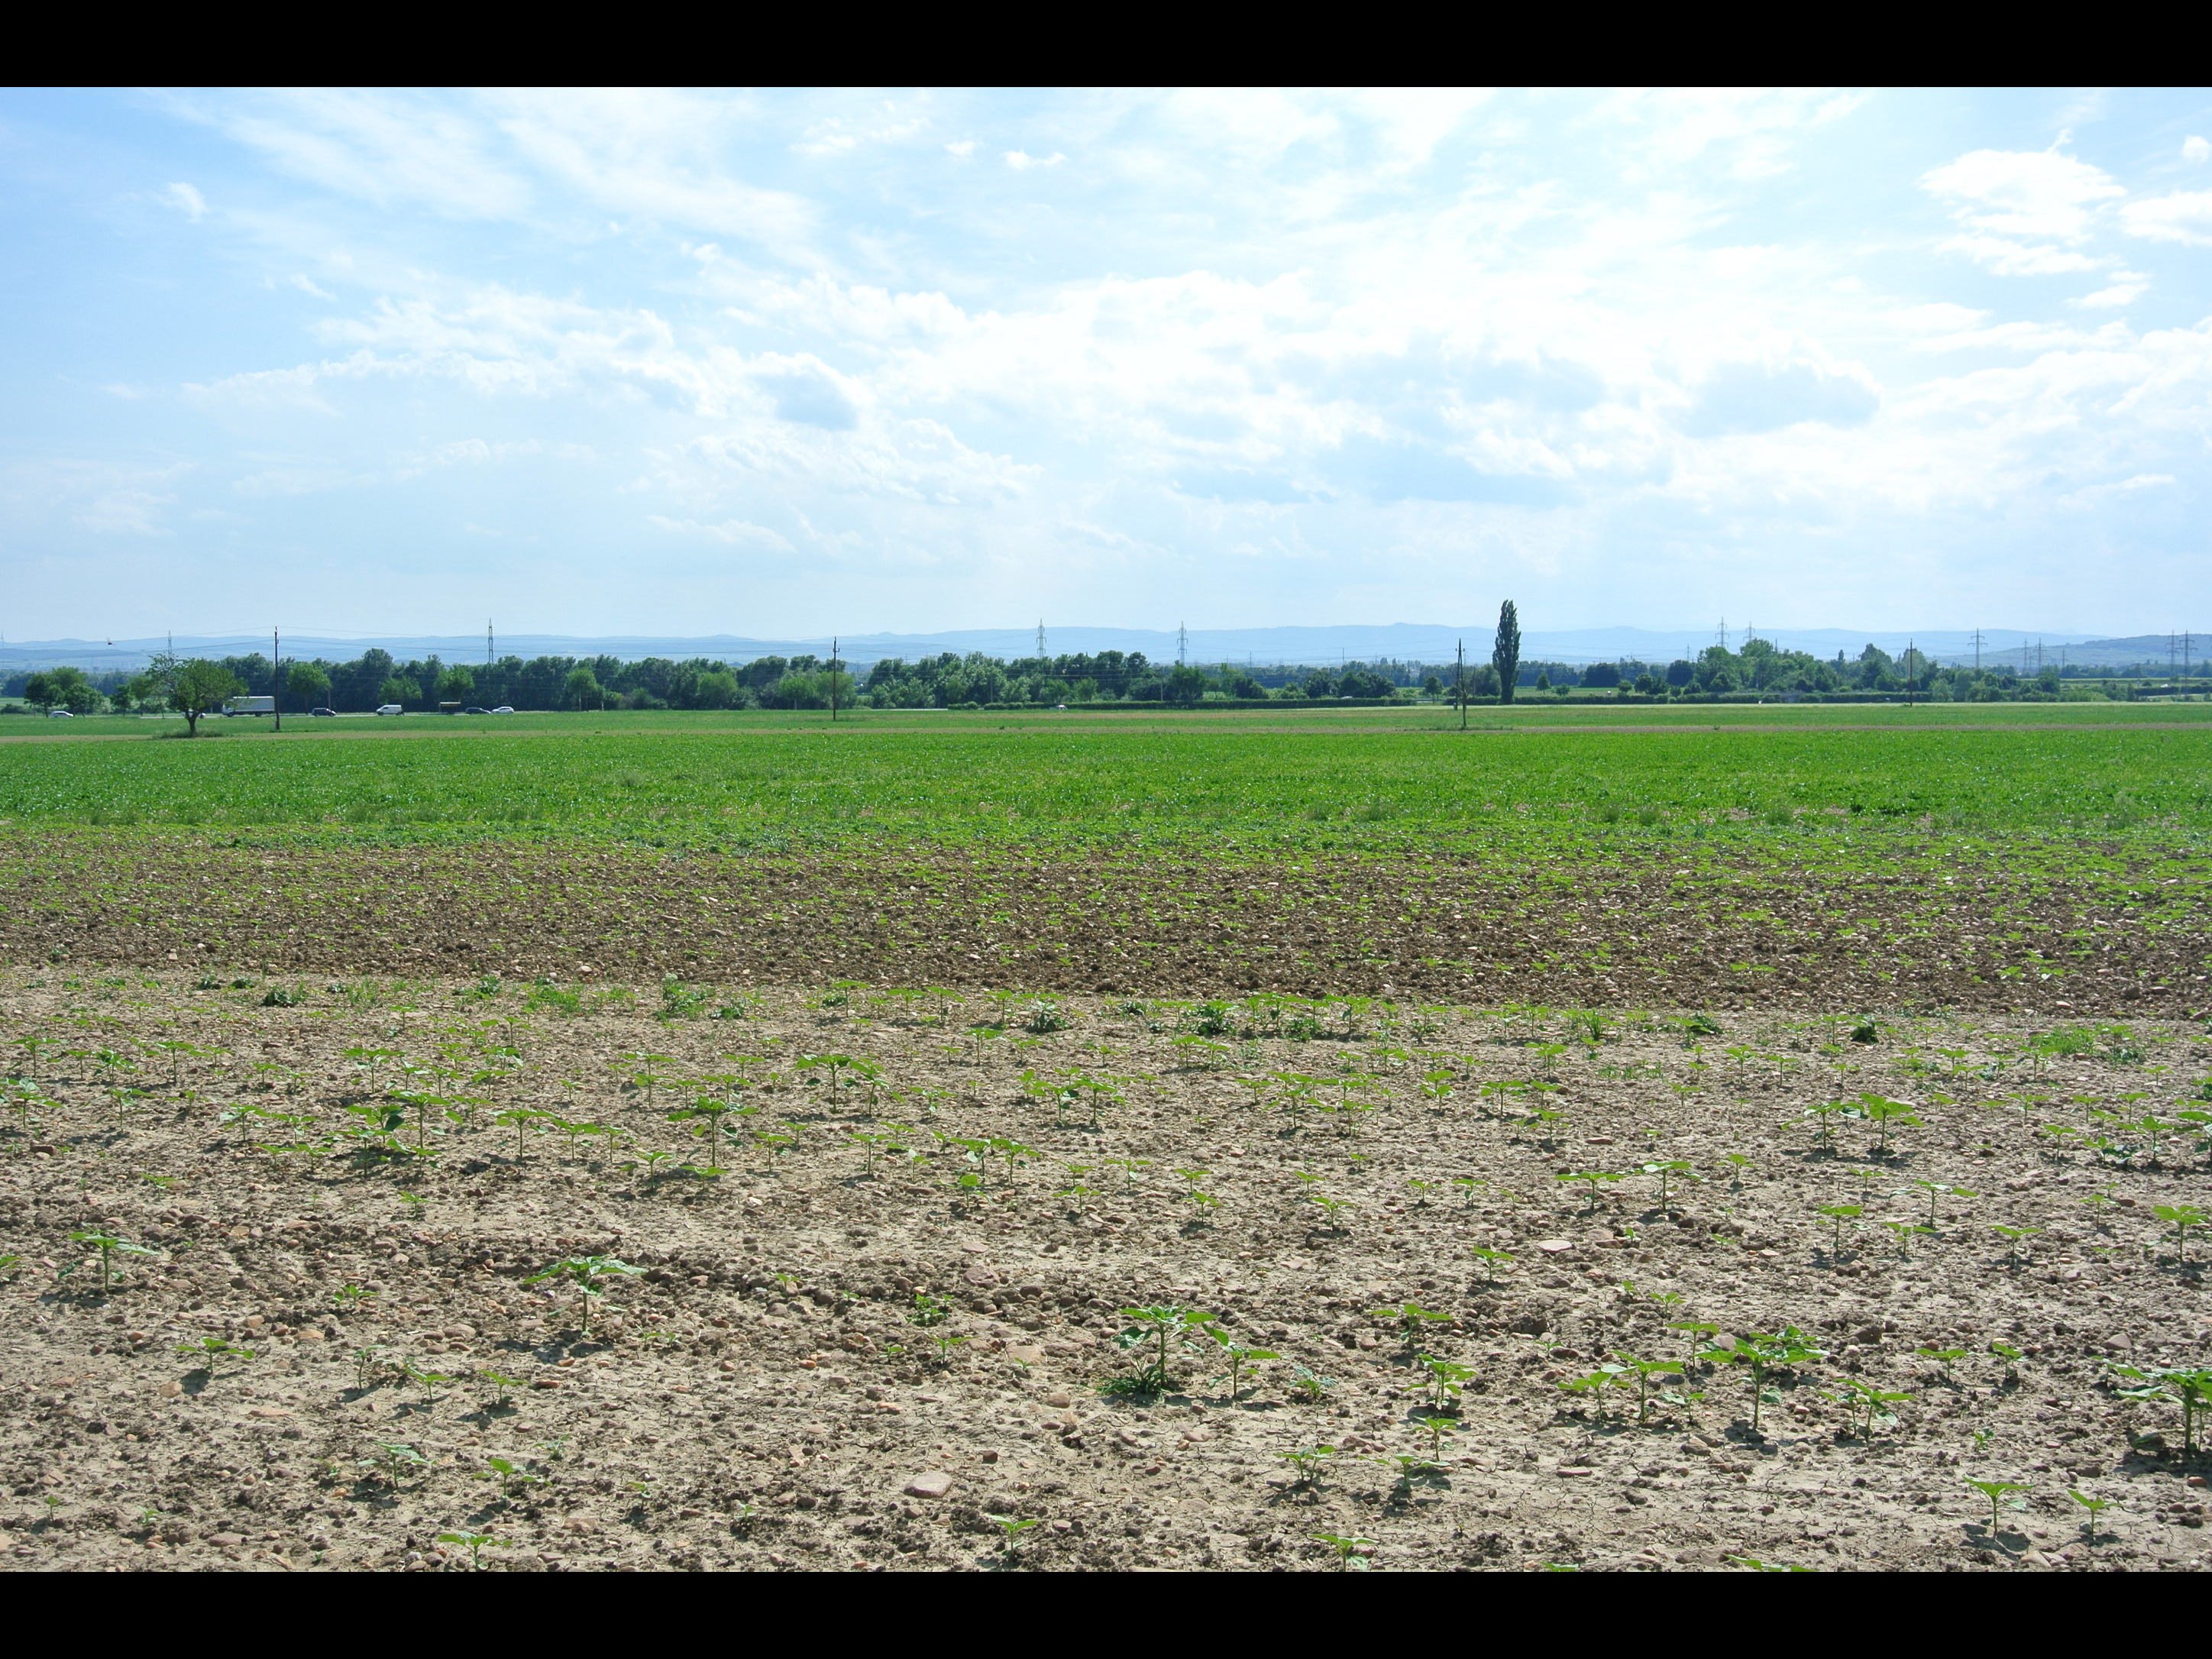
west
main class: Cropland
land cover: Sunflower
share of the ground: 10 - 25 %
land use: Agriculture (excluding fallow land and kitchen gardens)
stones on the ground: 25 - 50 %
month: June
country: AT
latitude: 47.8472
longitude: 16.5663
